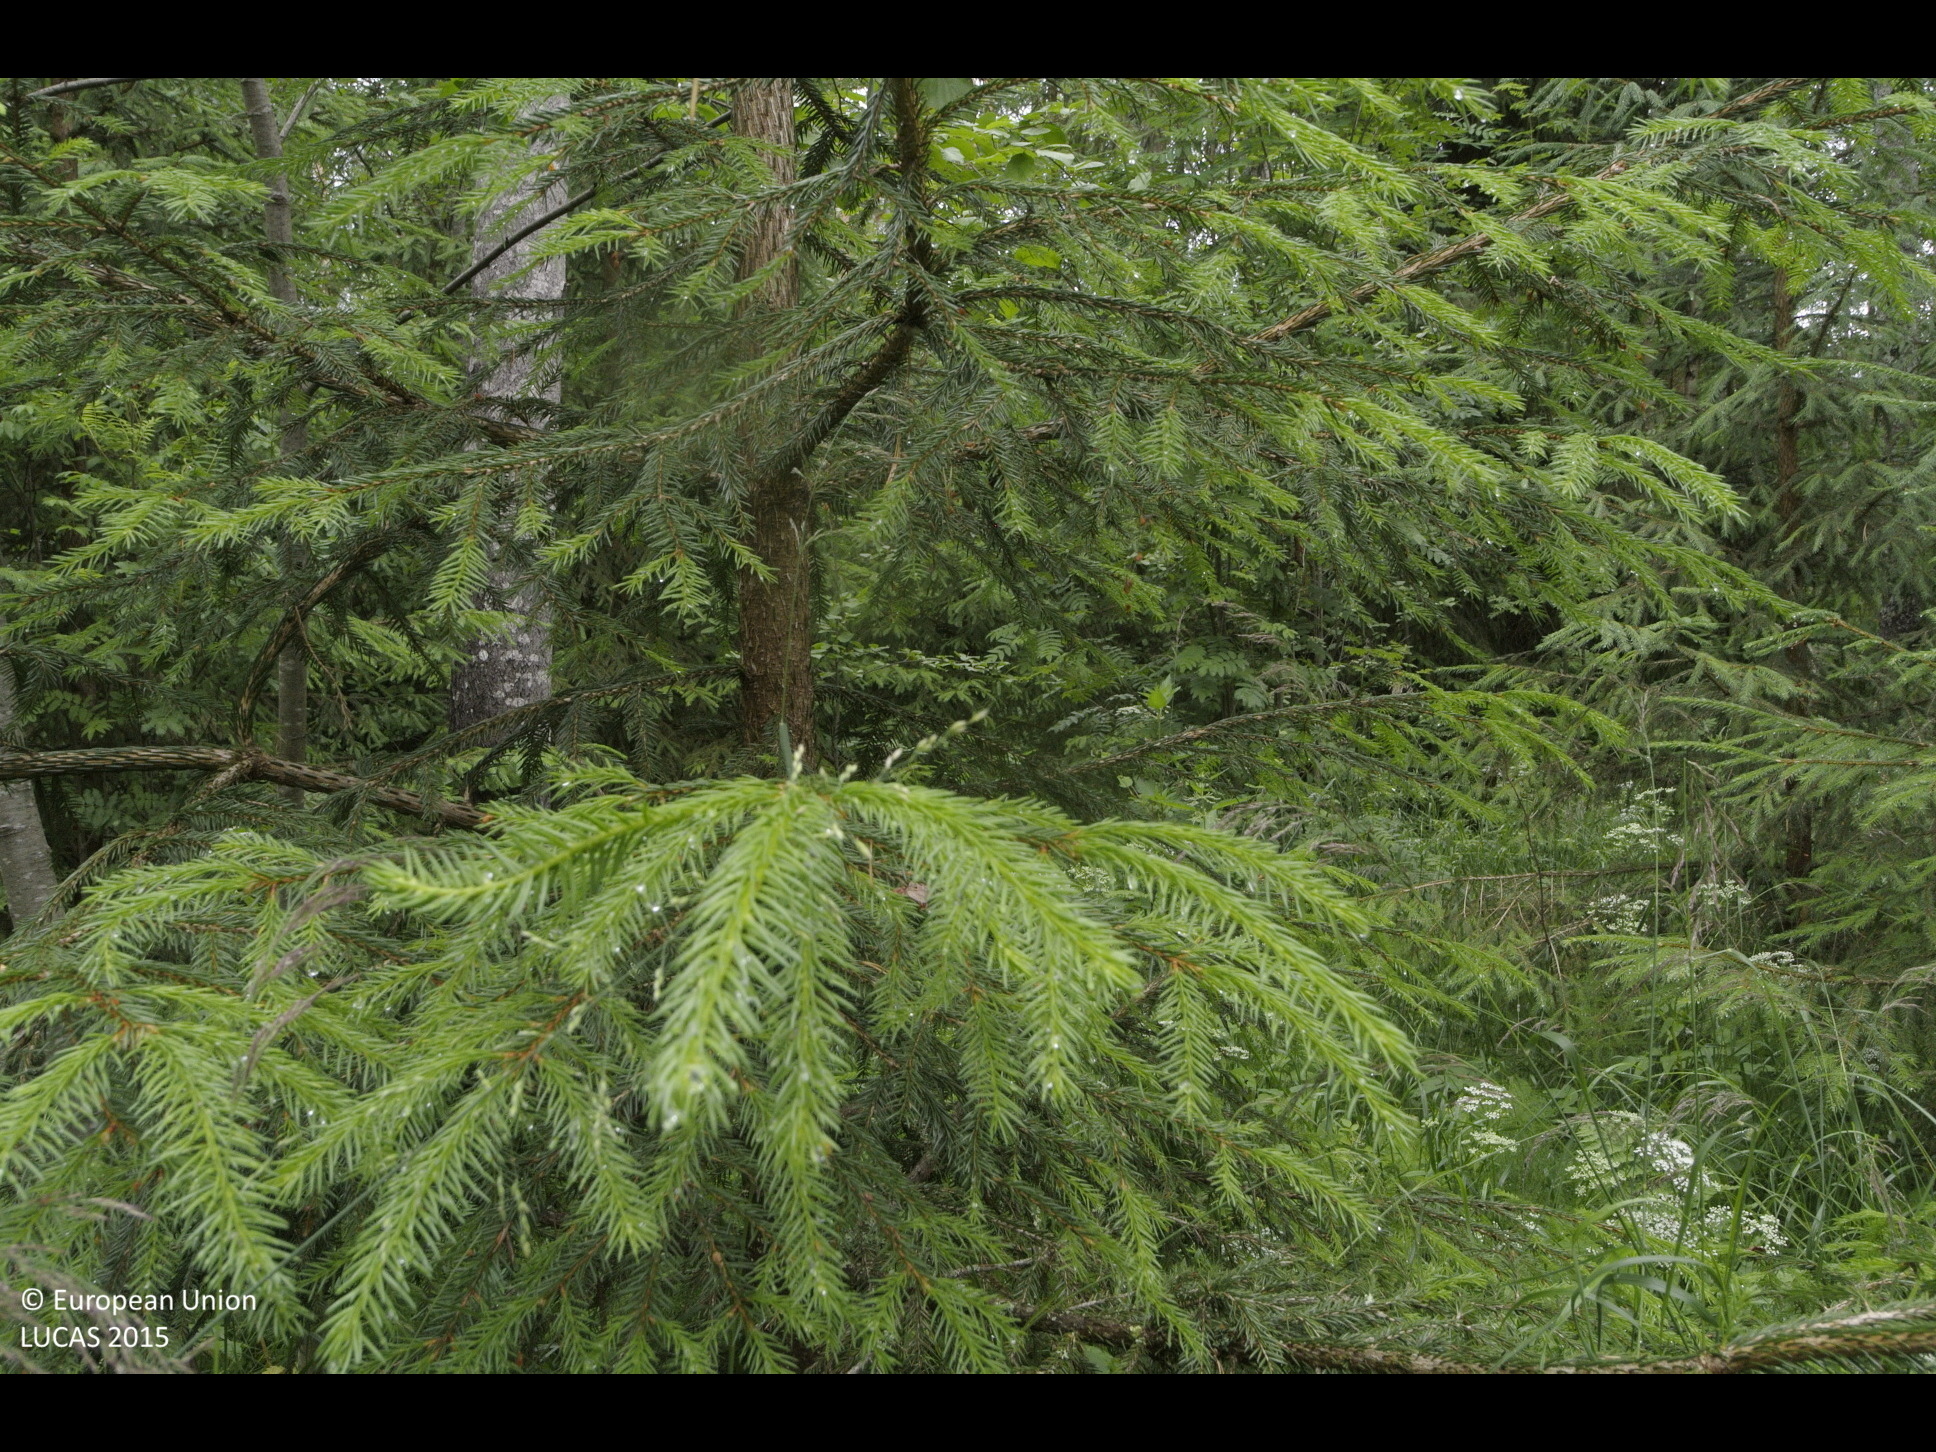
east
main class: Grassland
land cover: Grassland with sparse tree/shrub cover
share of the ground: > 75 %
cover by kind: herbaceous plants 90 %, coniferous forest trees 5 %, shrubs 5 %
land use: Semi-natural and natural areas not in use
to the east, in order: Grassland with sparse tree/shrub cover; Pine dominated mixed woodland; Fences; Pine dominated mixed woodland; Ditches and canals; Grass margins; Temporary grasslands; Broadleaved woodland; Arable land (only in case pi)
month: July
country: FI
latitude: 61.5093
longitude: 25.8207
